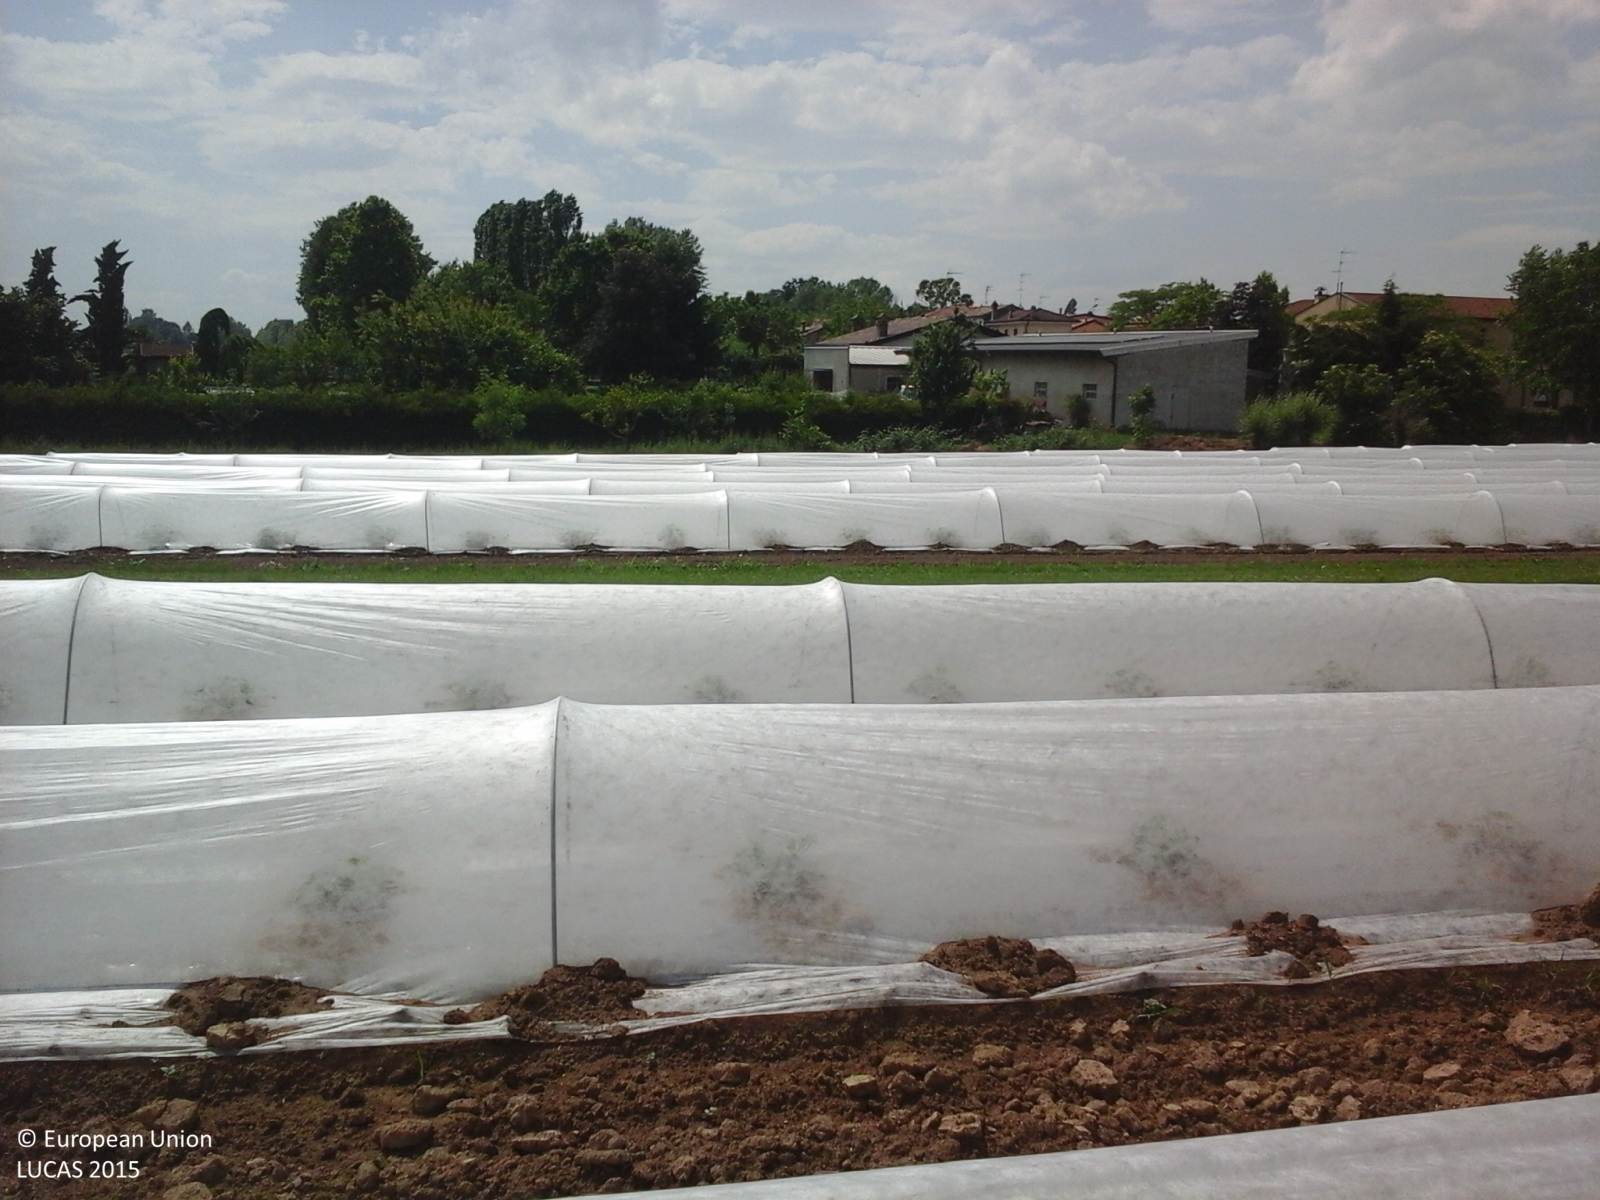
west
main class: Cropland
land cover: Other fresh vegetables
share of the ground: < 10 %
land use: Agriculture (excluding fallow land and kitchen gardens)
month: May
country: IT
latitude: 45.0875
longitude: 10.6974
